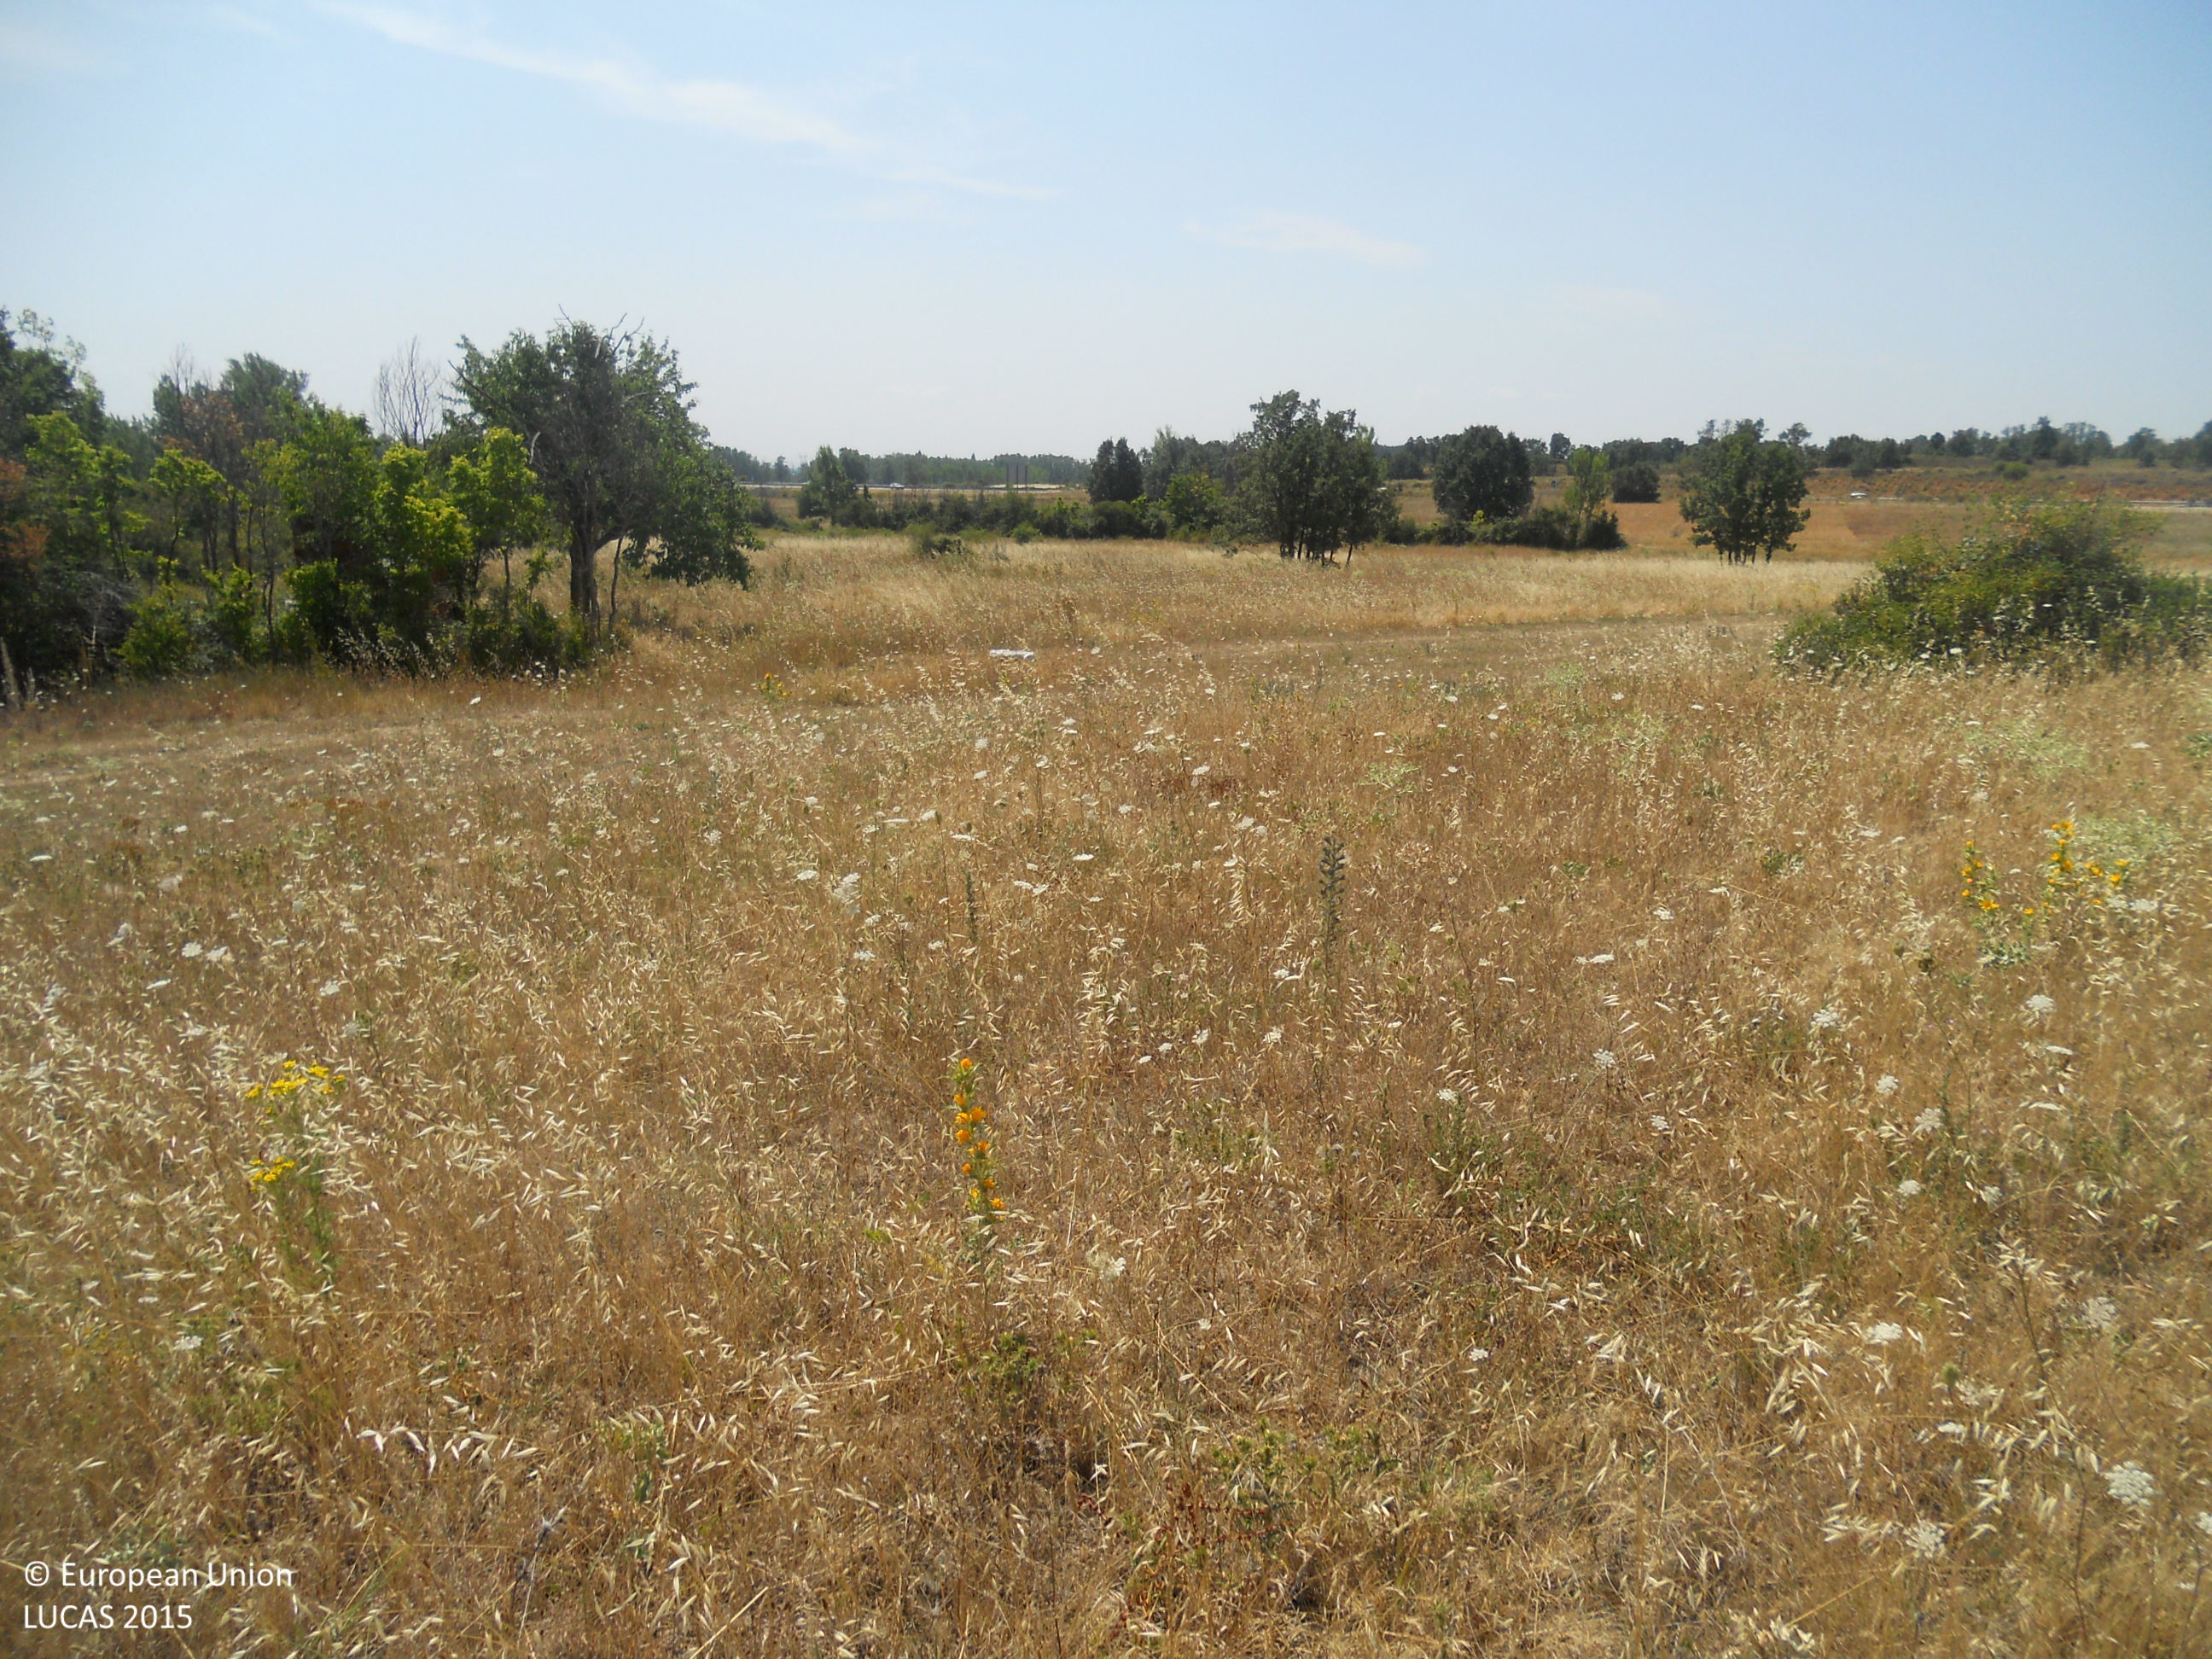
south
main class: Grassland
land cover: Grassland without tree/shrub cover
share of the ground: > 75 %
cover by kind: herbaceous plants 100 %
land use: Semi-natural and natural areas not in use
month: July
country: ES
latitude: 42.5738
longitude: -5.6064
